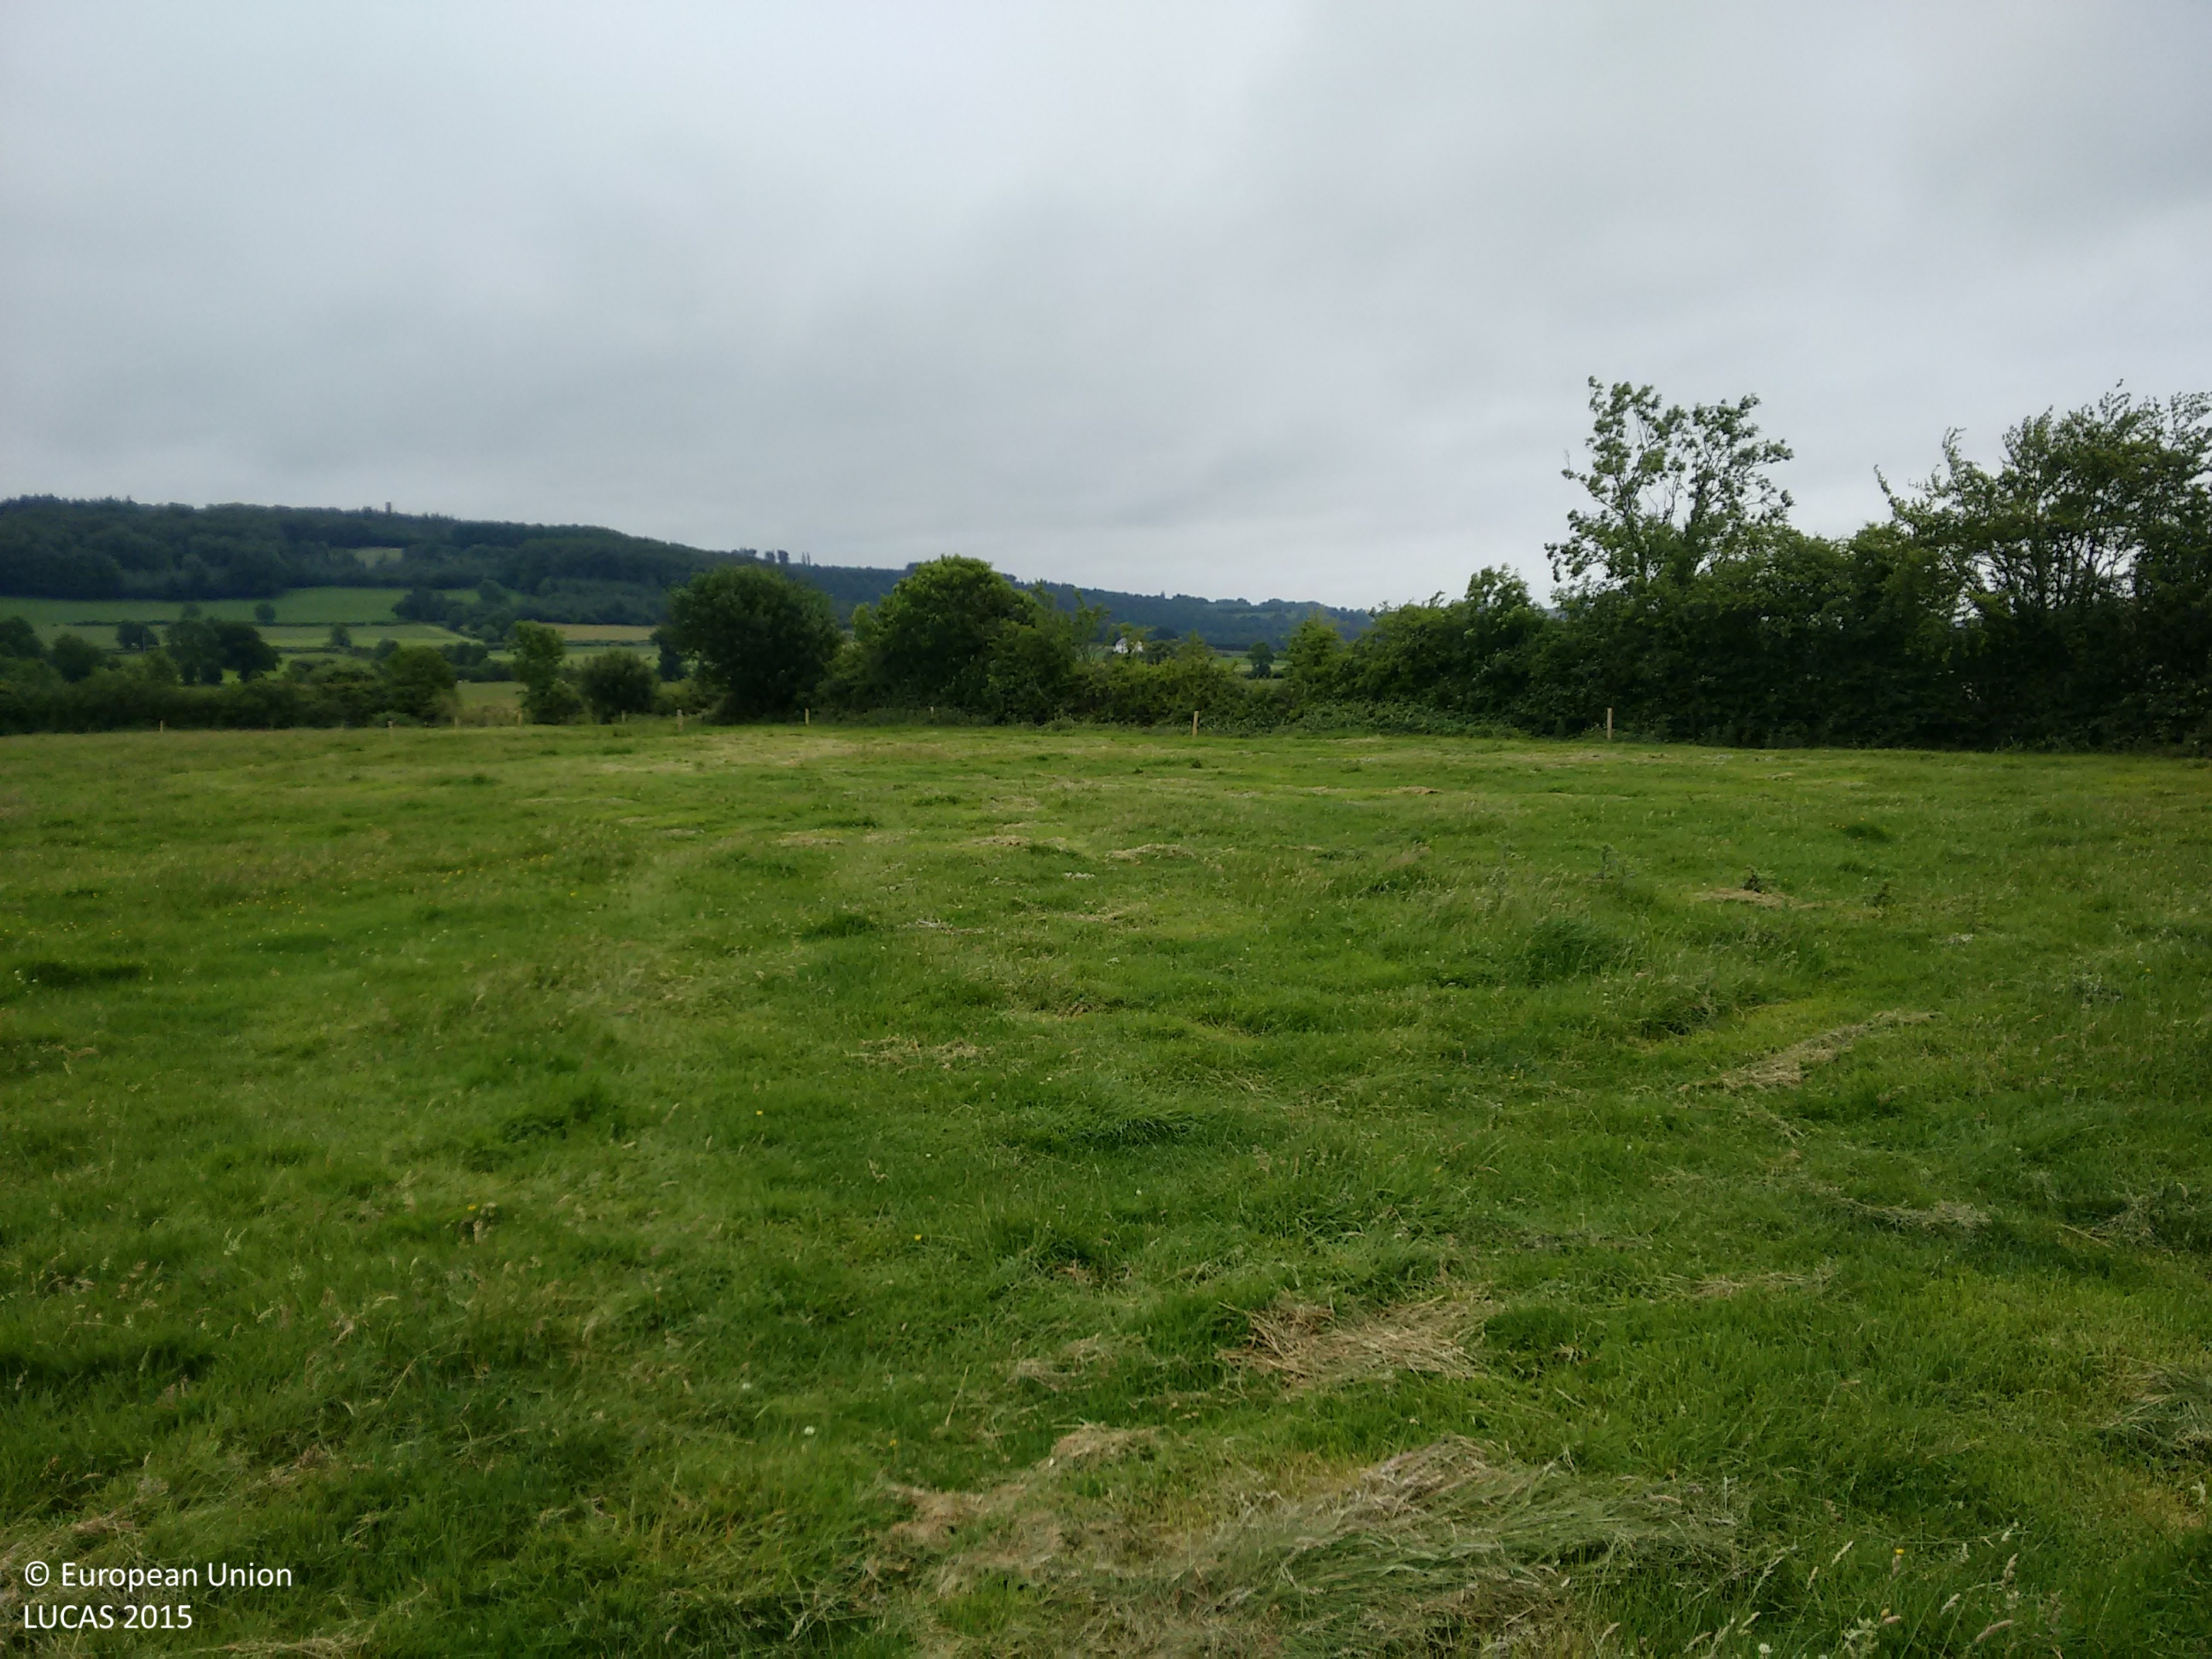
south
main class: Grassland
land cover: Grassland without tree/shrub cover
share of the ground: > 75 %
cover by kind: herbaceous plants 95 %, unconsolidated bare surface 5 %
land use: Agriculture (excluding fallow land and kitchen gardens)
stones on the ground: < 10 %
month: July
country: IE
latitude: 52.6780
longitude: -7.5392
